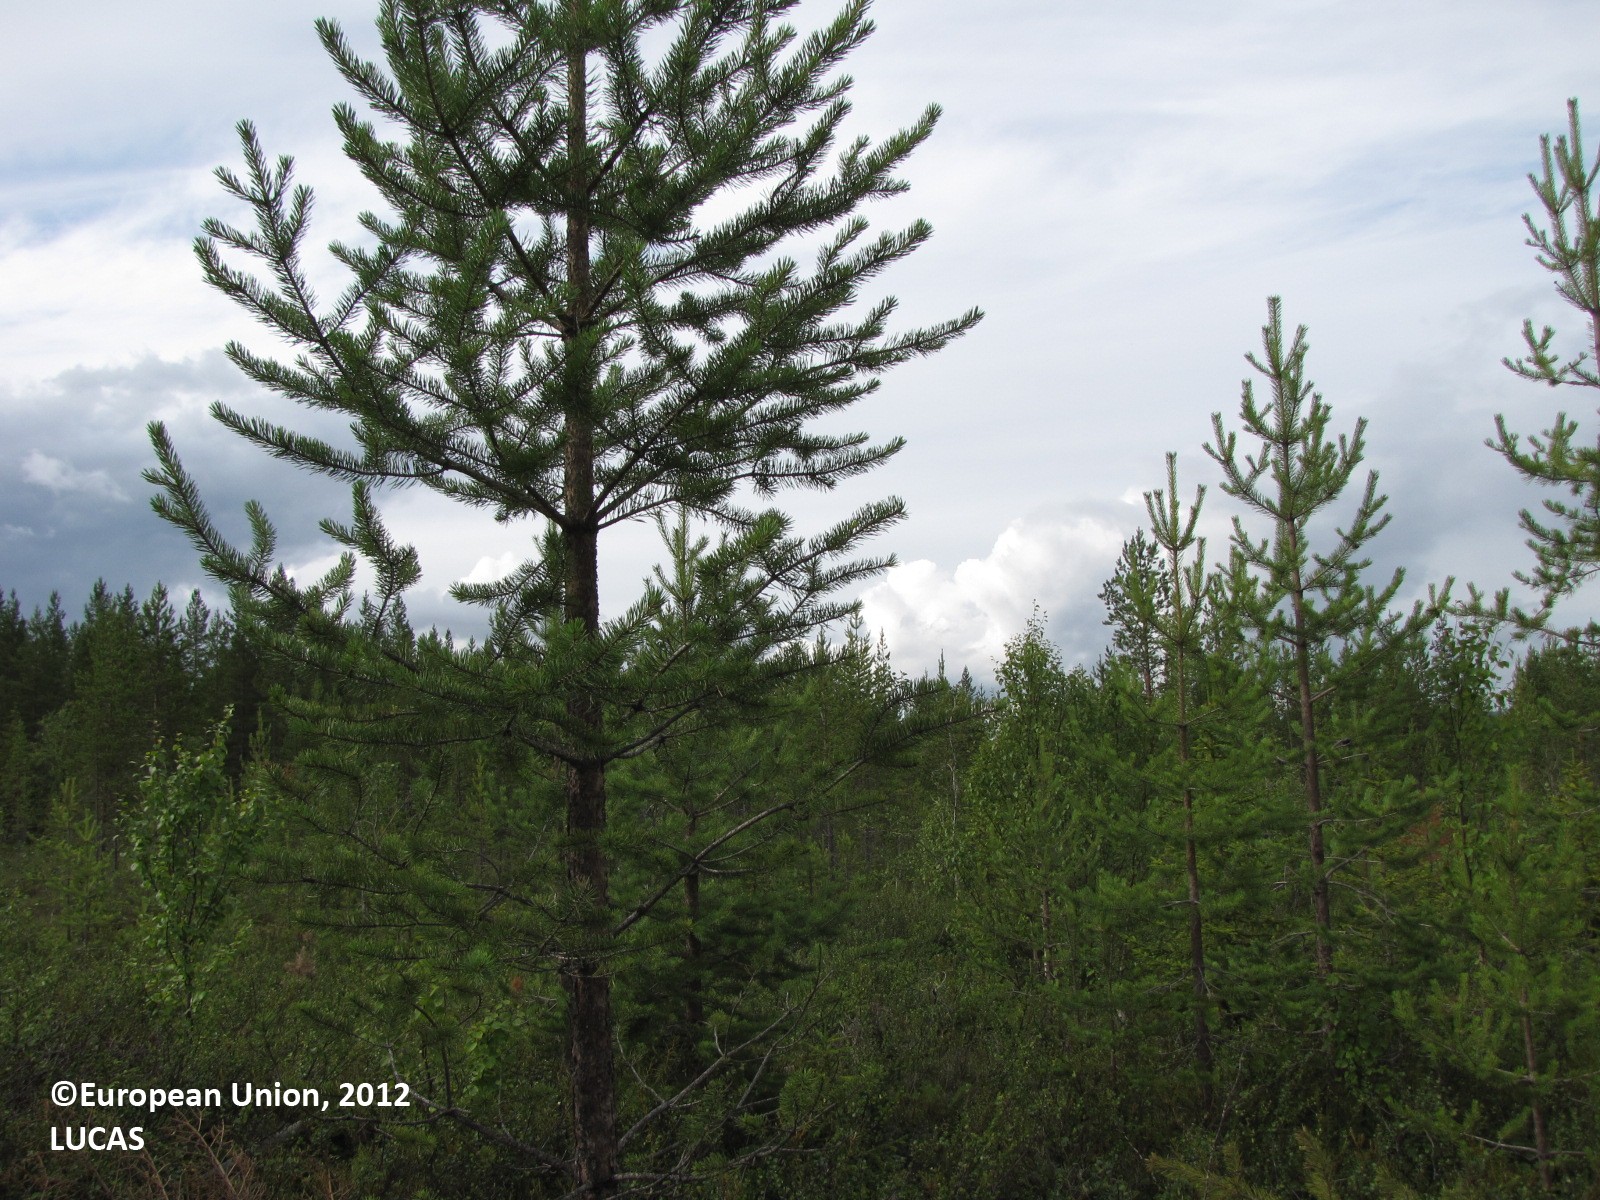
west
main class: Woodland
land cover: Pine dominated mixed woodland
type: boreal forest
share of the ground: 25 - 50 %
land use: Forestry
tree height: > 5 m
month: August
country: FI
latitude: 66.7328
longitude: 24.5385
